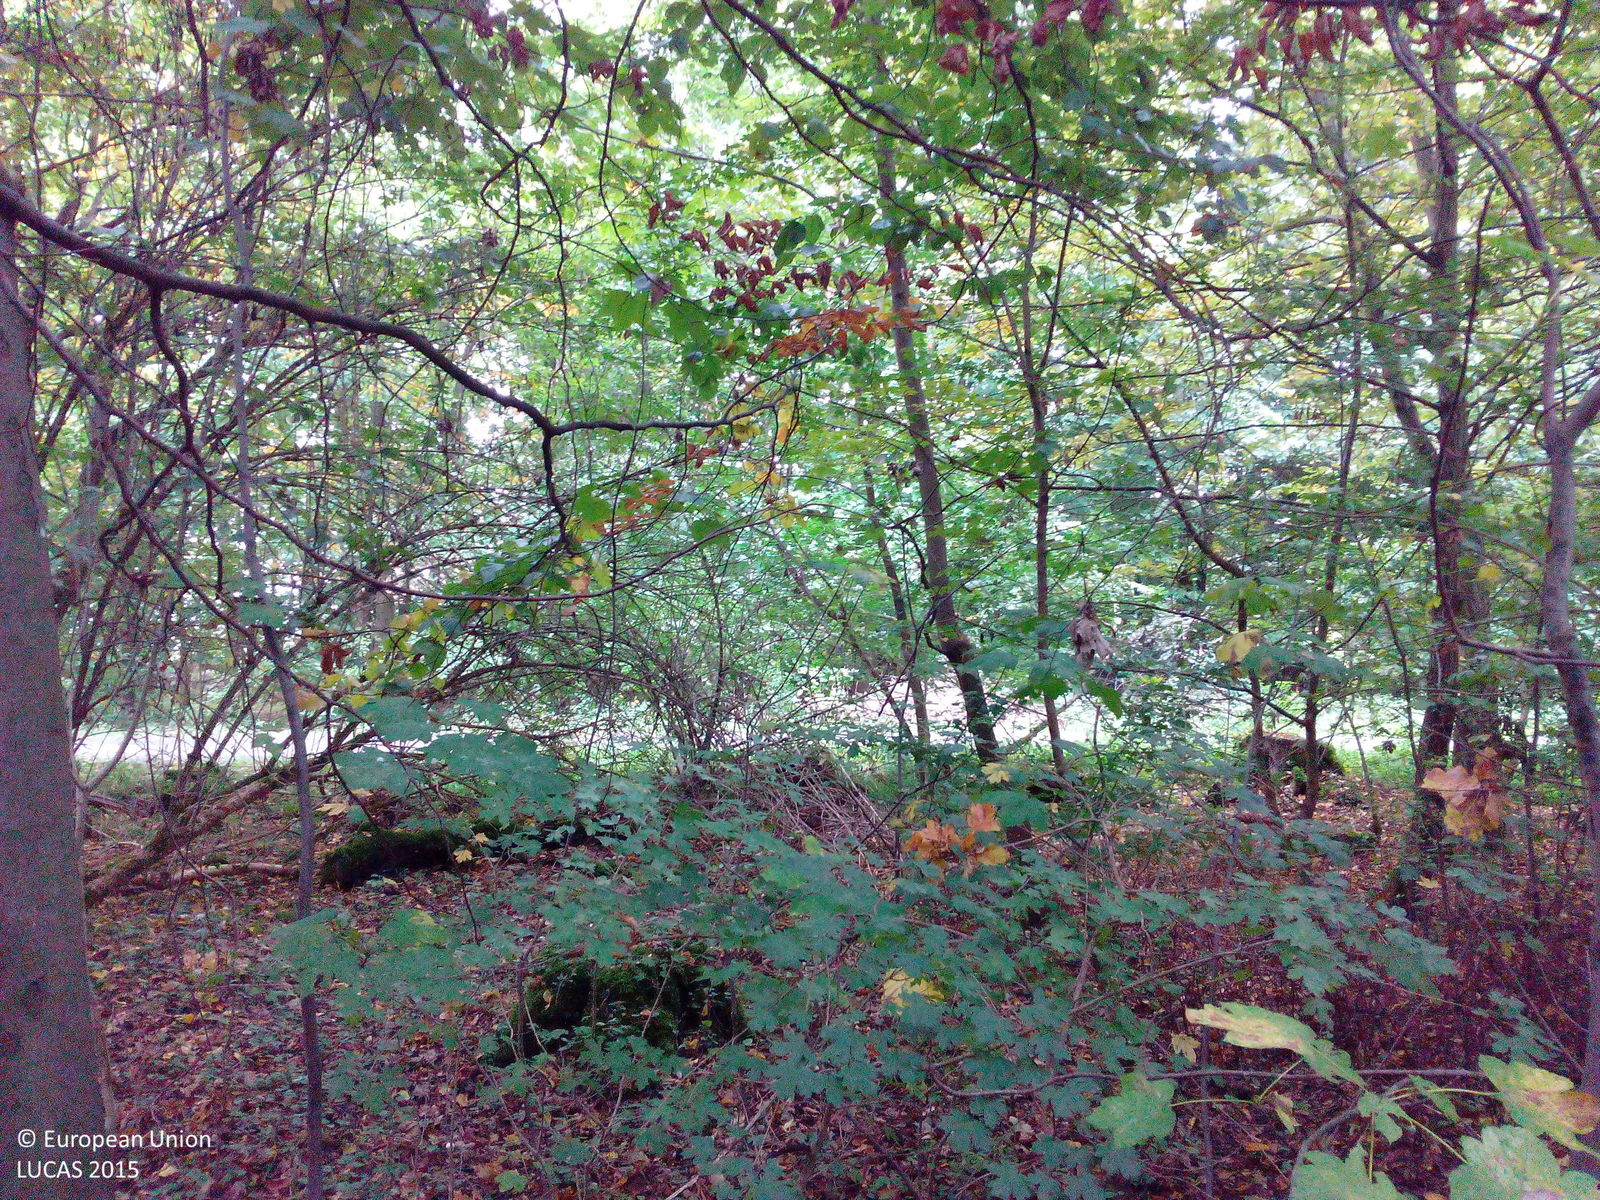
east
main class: Woodland
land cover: Broadleaved woodland
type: mesophytic deciduous forest
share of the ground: > 75 %
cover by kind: broadleaved forest trees 100 %
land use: Forestry
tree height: > 5 m
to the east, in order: Broadleaved woodland; Tracks; Broadleaved woodland; Other bare soil; Spruce dominated mixed woodland; Broadleaved woodland; Artificial constructions in urban areas; Rape and turnip rape
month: September
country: DE
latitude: 51.5505
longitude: 9.8414
